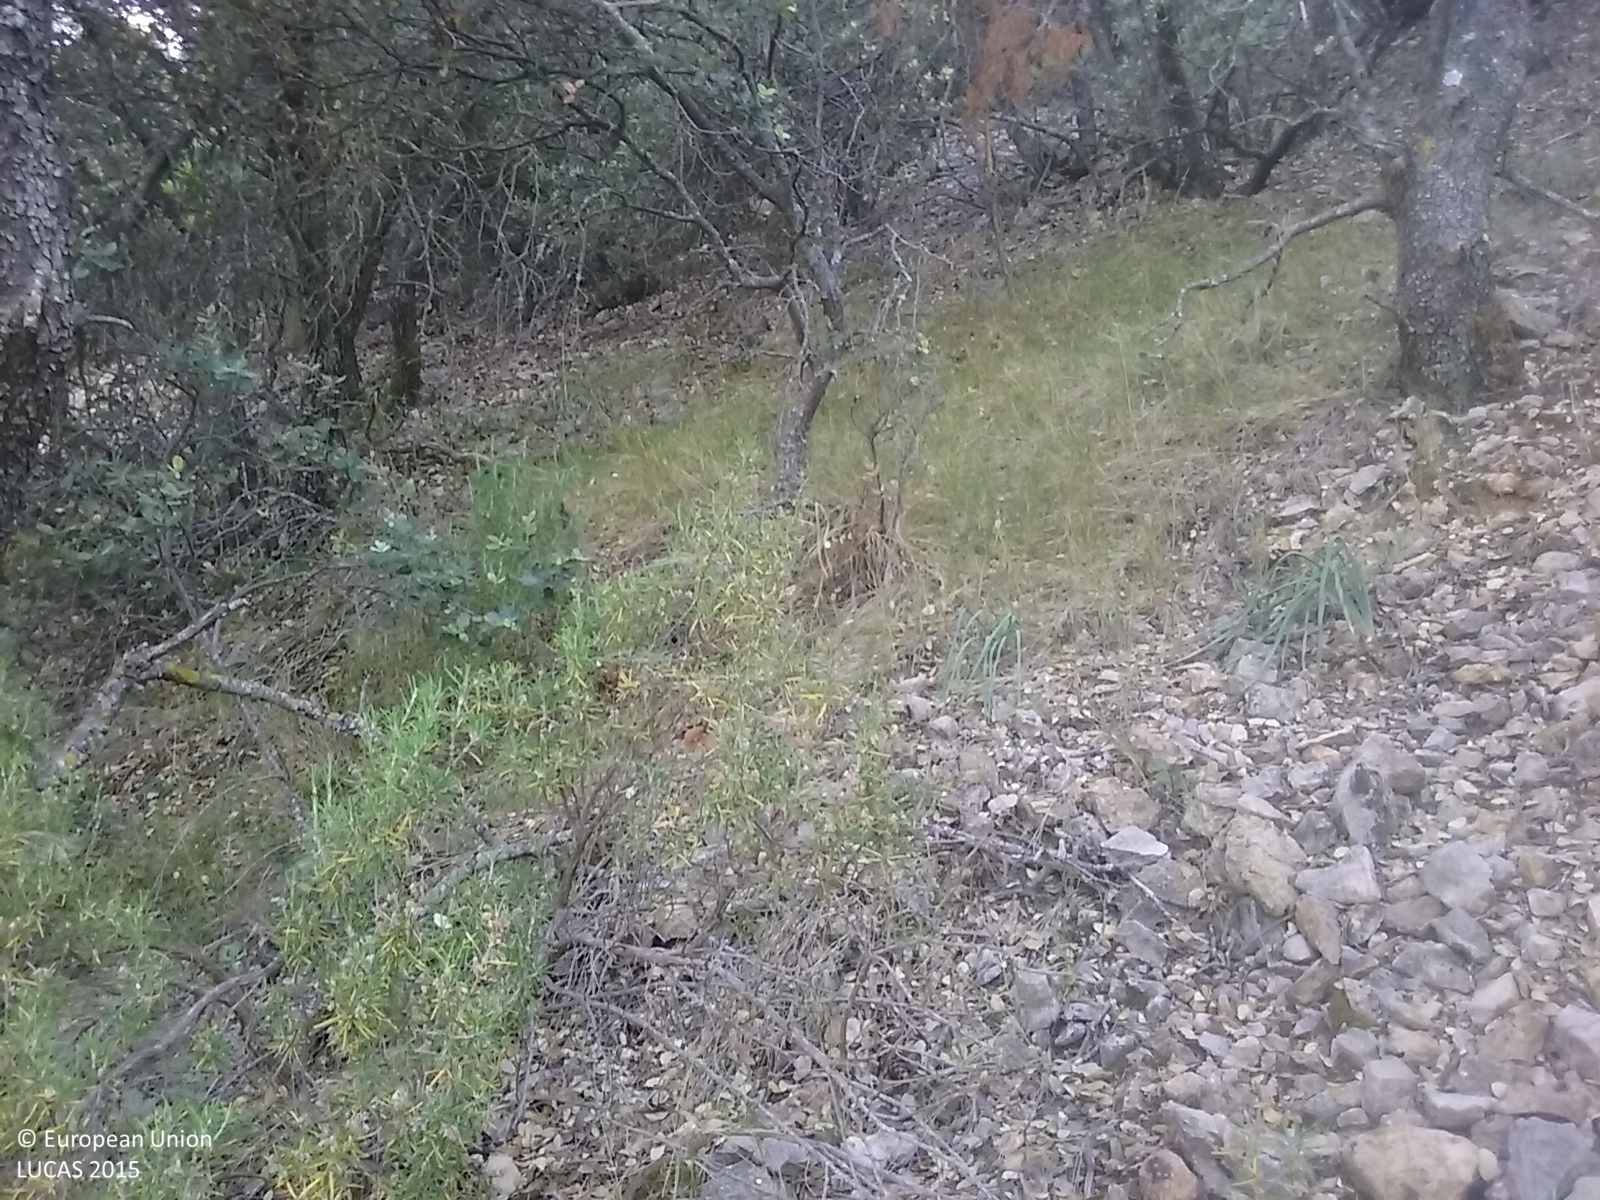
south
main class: Woodland
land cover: Pine dominated mixed woodland
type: coniferous forest of the mediterranean region
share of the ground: > 75 %
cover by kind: coniferous forest trees 50 %, broadleaved forest trees 40 %, shrubs 10 %
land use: Semi-natural and natural areas not in use
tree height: > 5 m
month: June
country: ES
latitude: 40.7301
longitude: -0.0843
